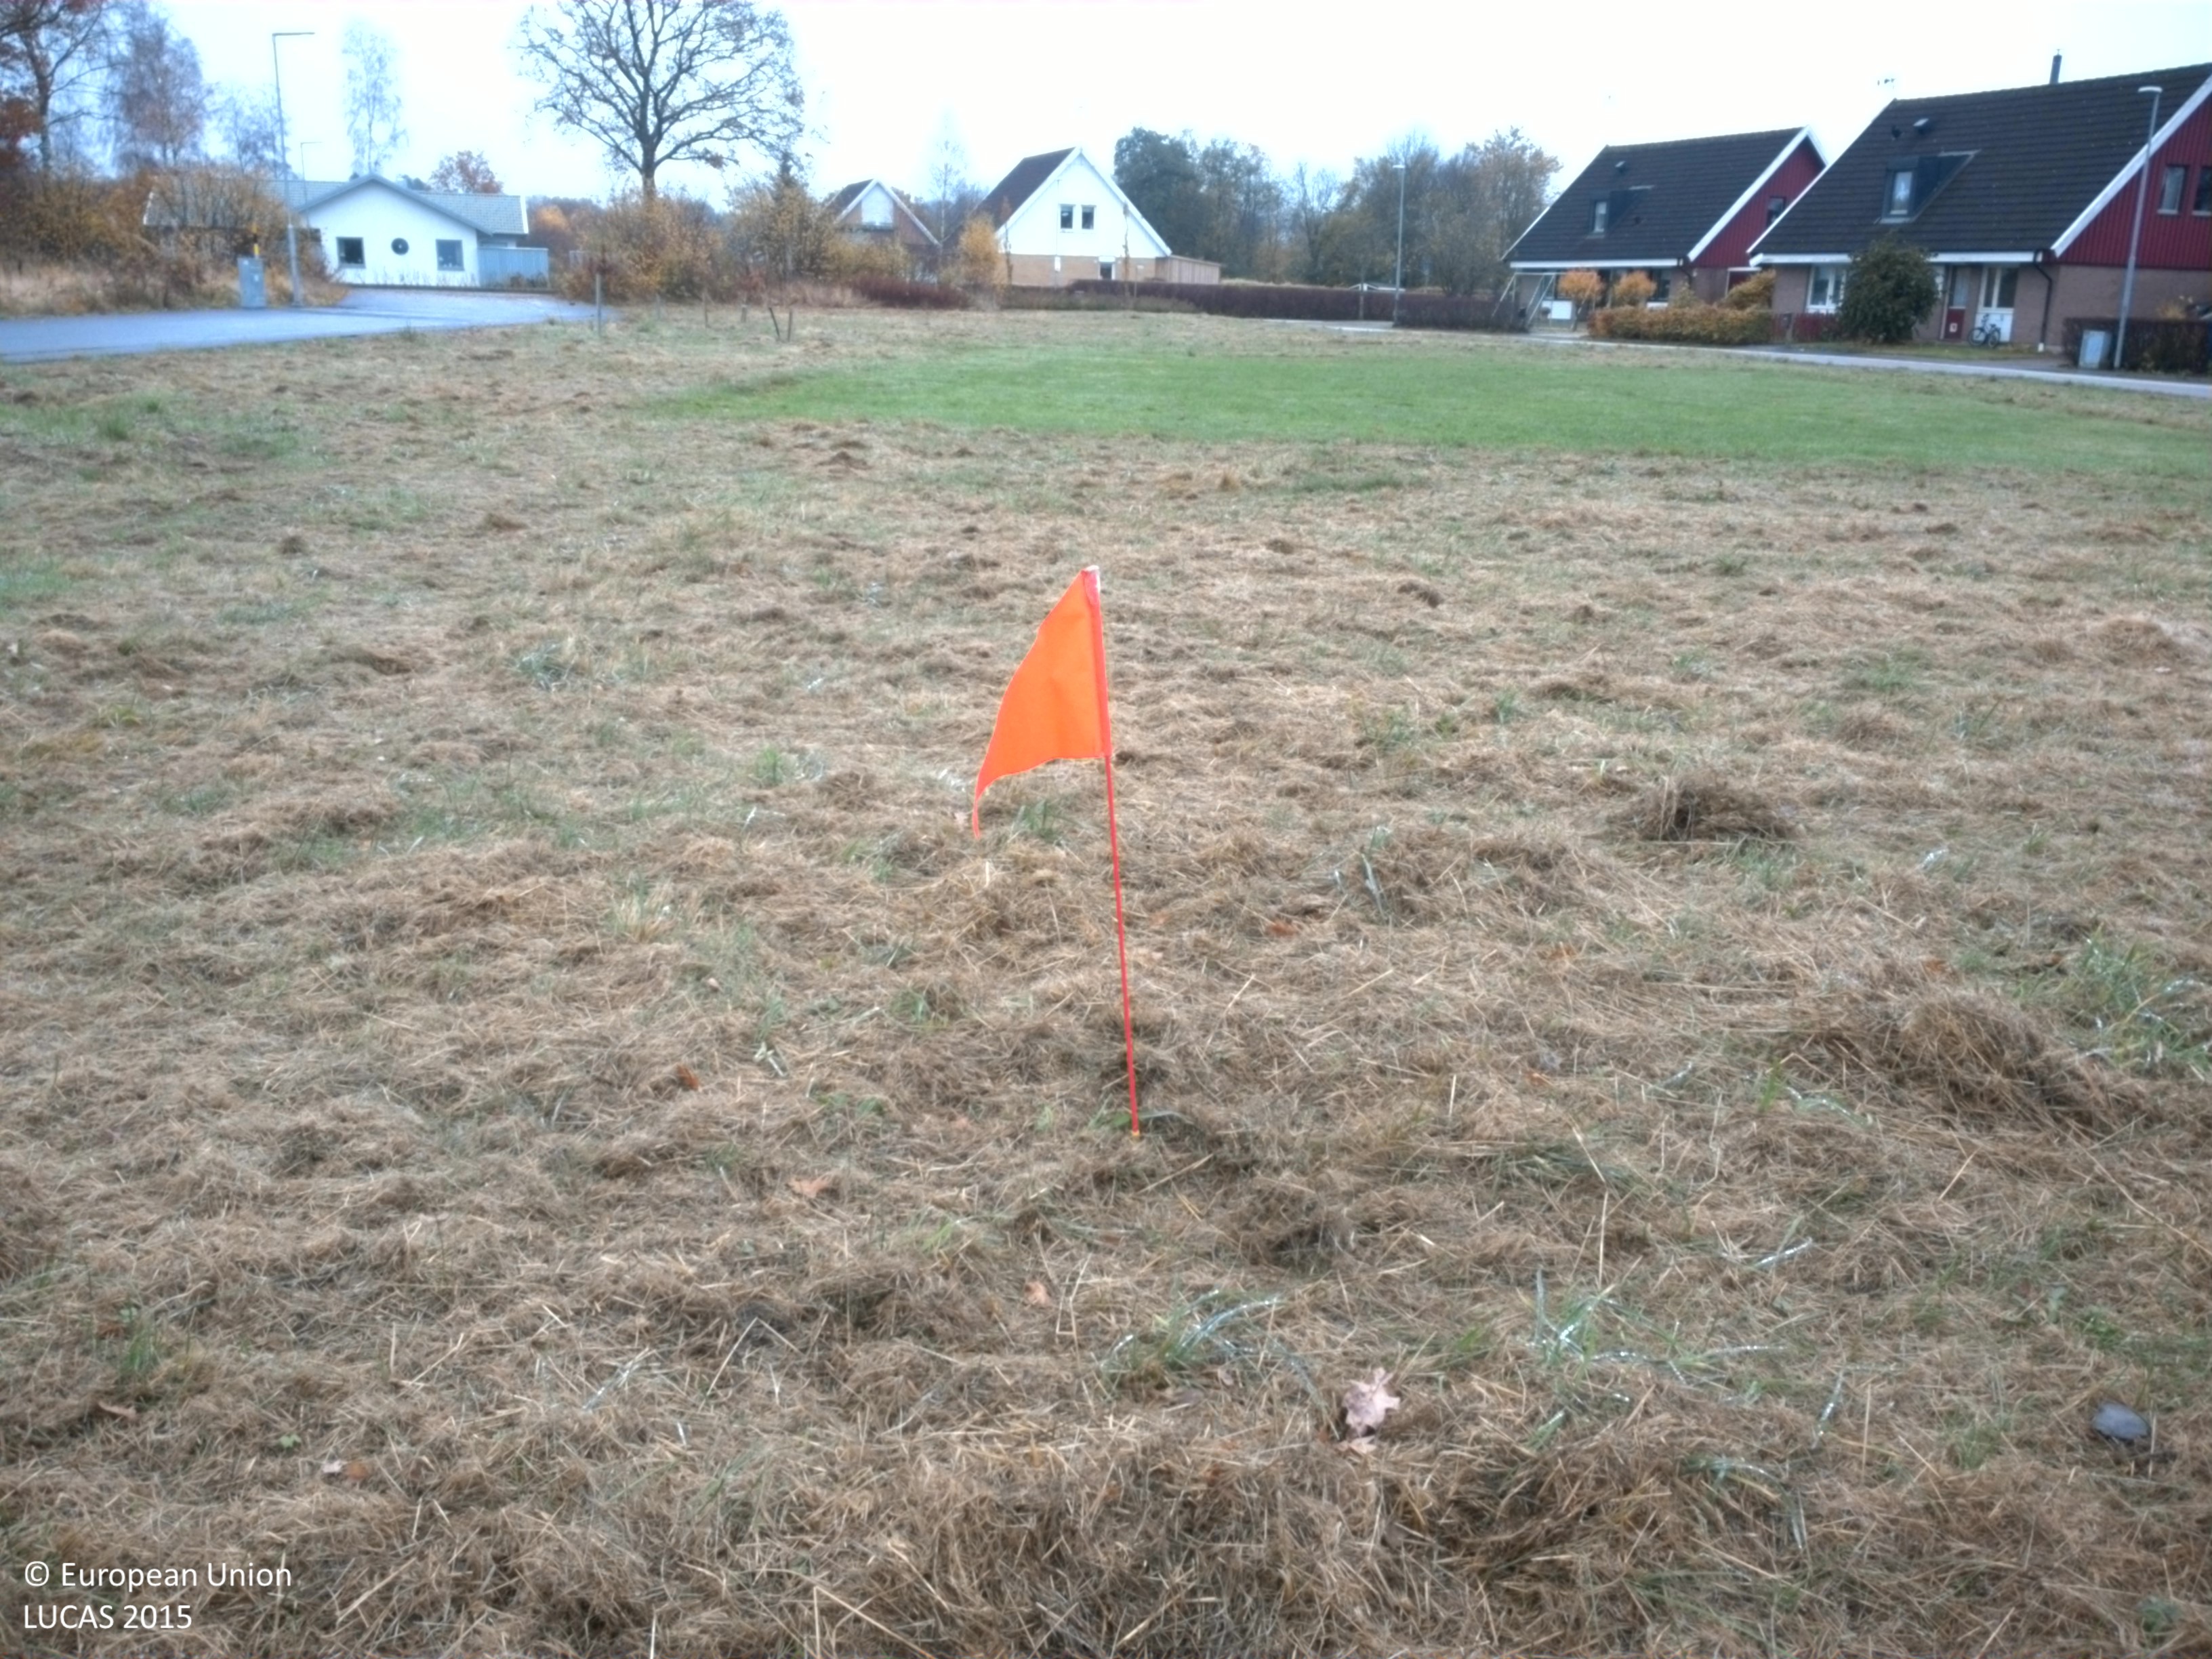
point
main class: Grassland
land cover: Grassland without tree/shrub cover
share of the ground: > 75 %
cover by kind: herbaceous plants 100 %
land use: Residential
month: November
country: SE
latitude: 56.0066
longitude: 13.0928
